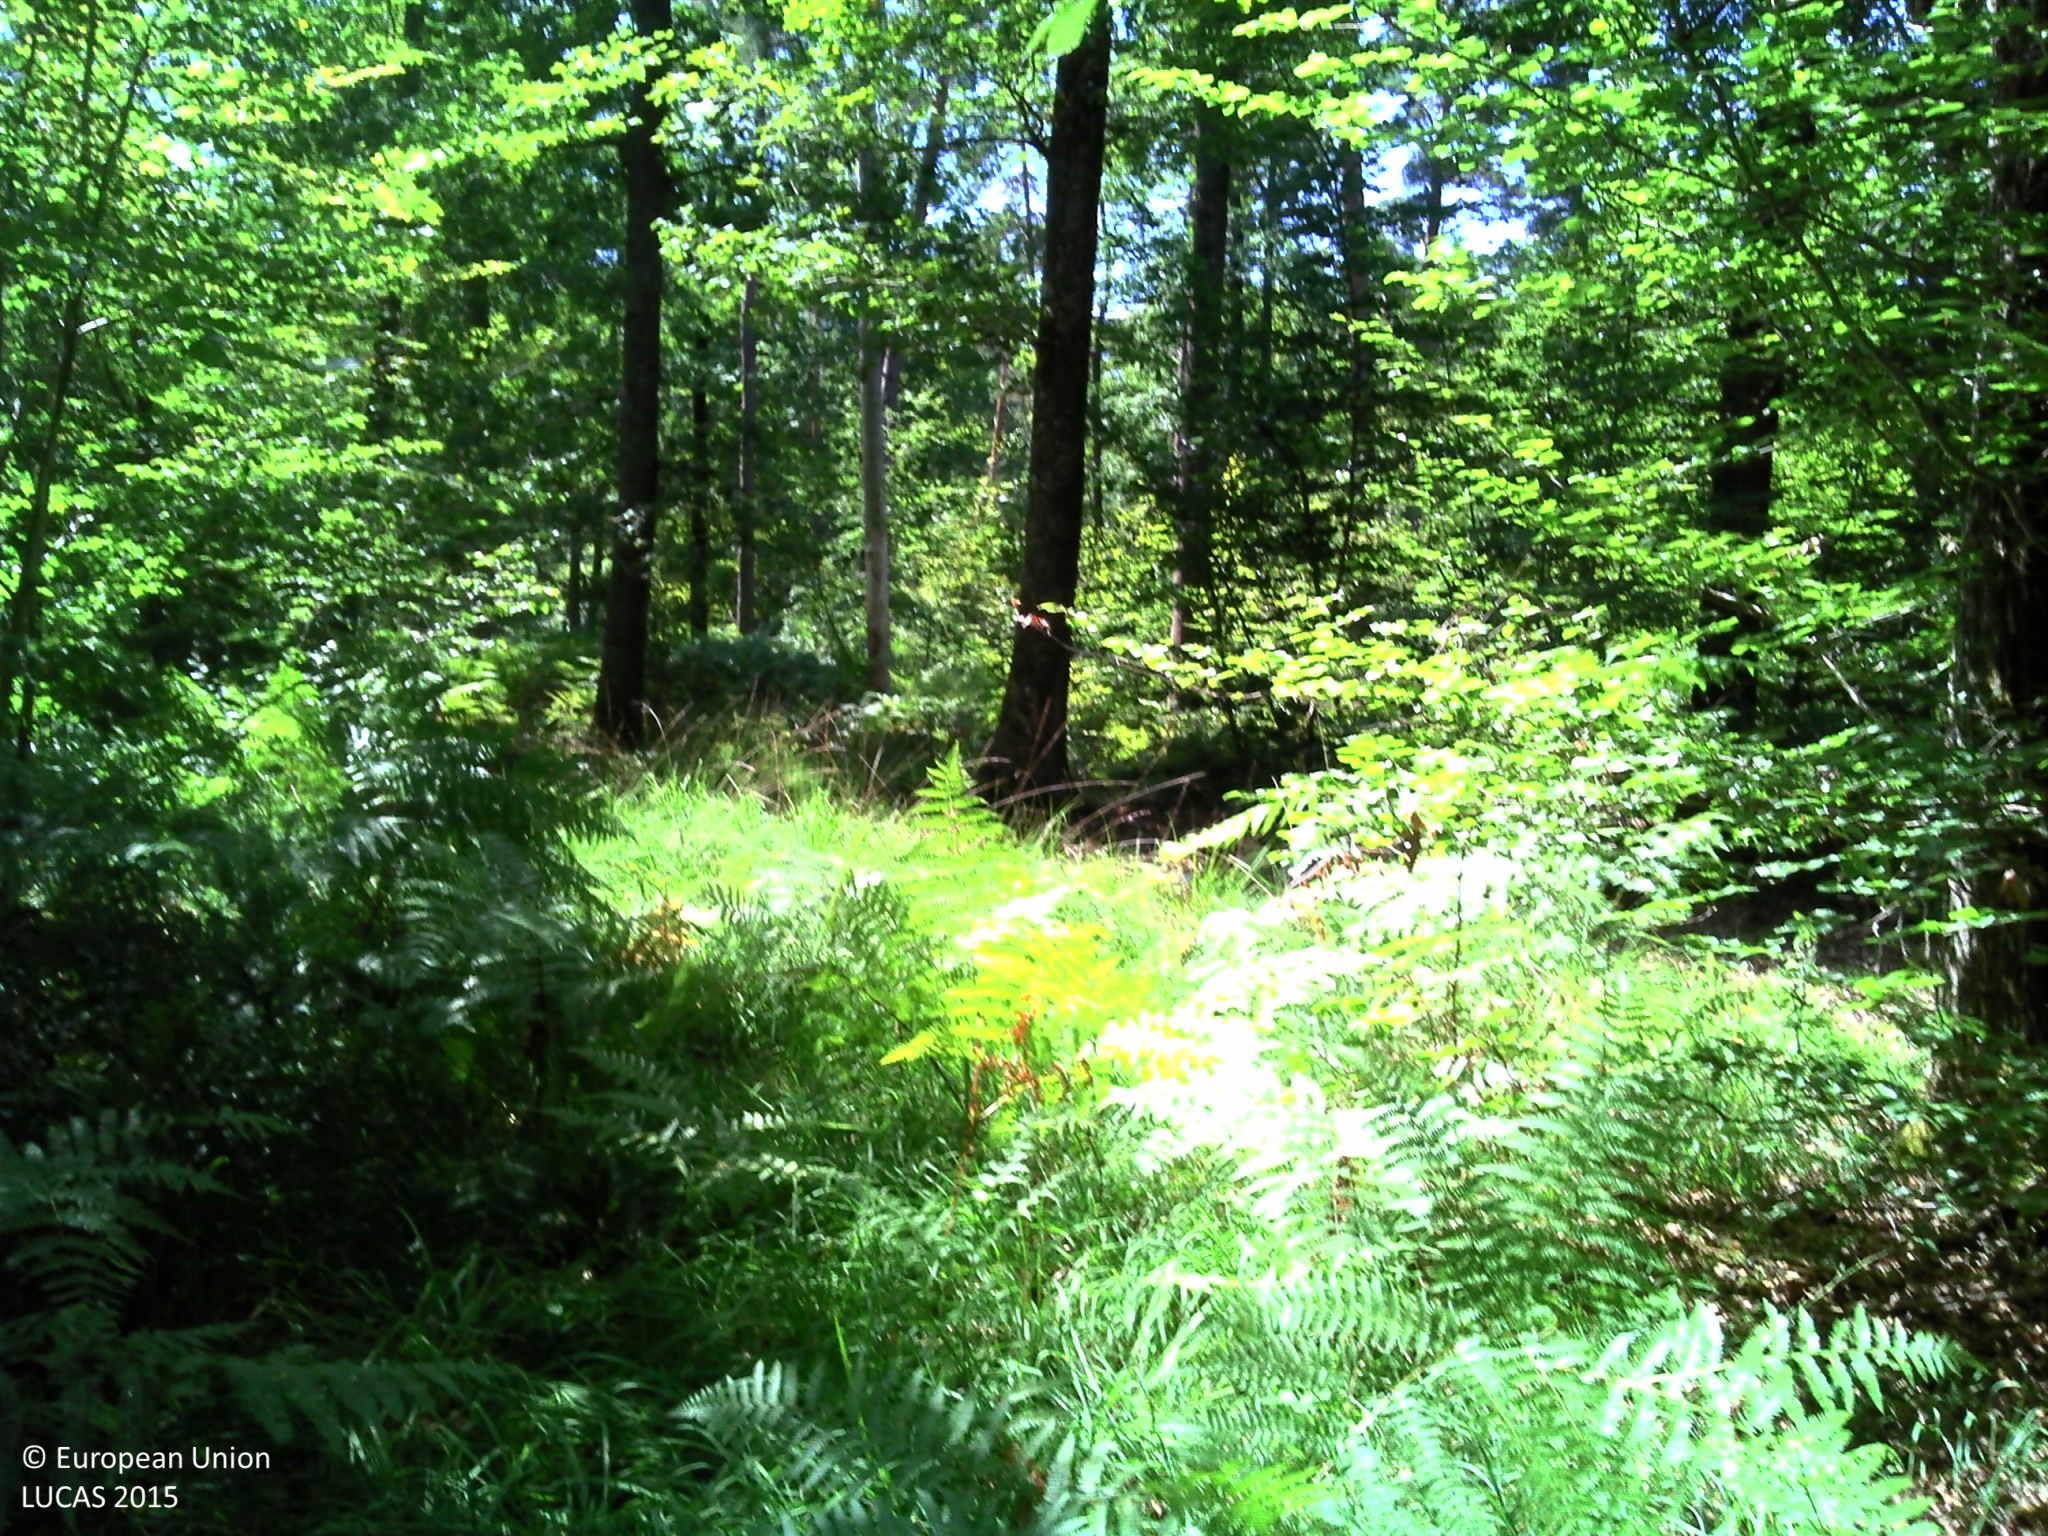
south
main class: Woodland
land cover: Pine dominated mixed woodland
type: mesophytic deciduous forest
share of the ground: > 75 %
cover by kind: broadleaved forest trees 50 %, coniferous forest trees 40 %, herbaceous plants 10 %
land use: Forestry
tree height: > 5 m
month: August
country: FR
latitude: 47.2688
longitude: 2.0732
